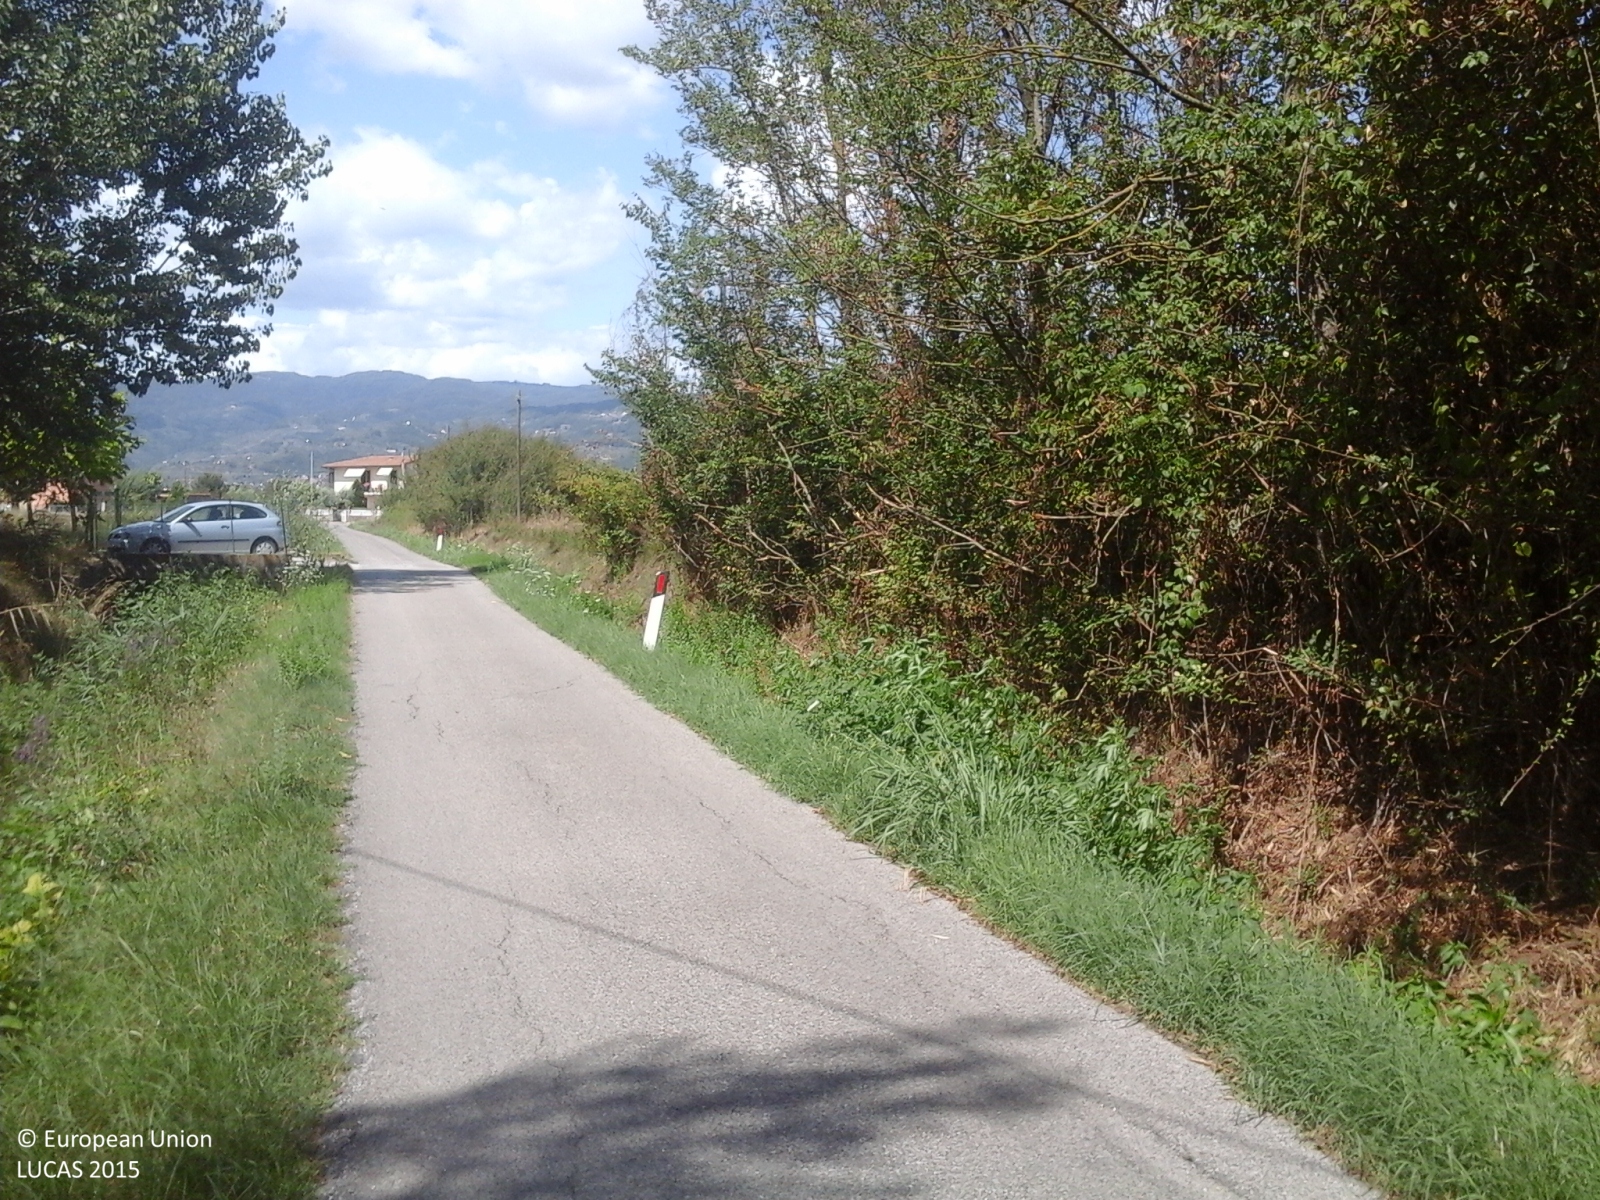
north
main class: Grassland
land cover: Grassland without tree/shrub cover
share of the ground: > 75 %
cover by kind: herbaceous plants 100 %
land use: Residential
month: August
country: IT
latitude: 43.8605
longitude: 10.7818
